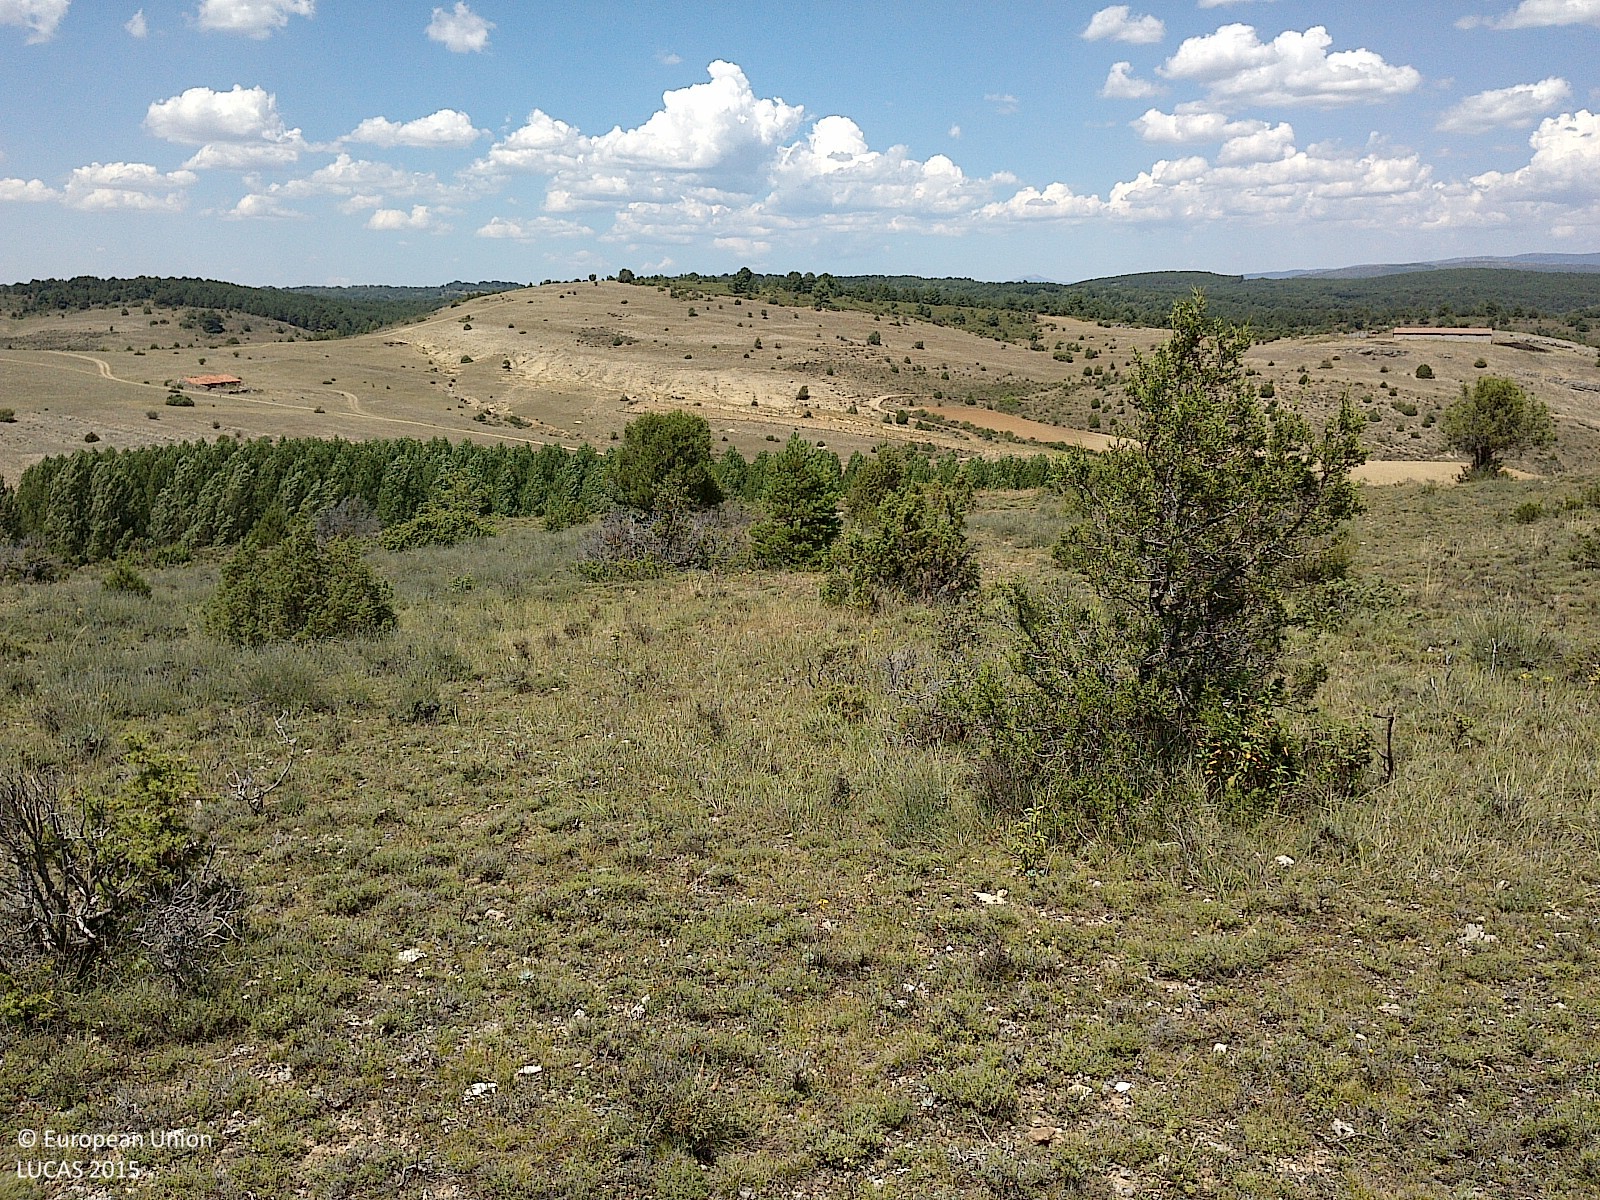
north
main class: Grassland
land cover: Grassland with sparse tree/shrub cover
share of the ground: > 75 %
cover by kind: herbaceous plants 85 %, coniferous forest trees 5 %, shrubs 5 %, consolidated bare surface 5 %
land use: Semi-natural and natural areas not in use
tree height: < 5 m
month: July
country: ES
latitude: 41.8603
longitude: -3.1907
